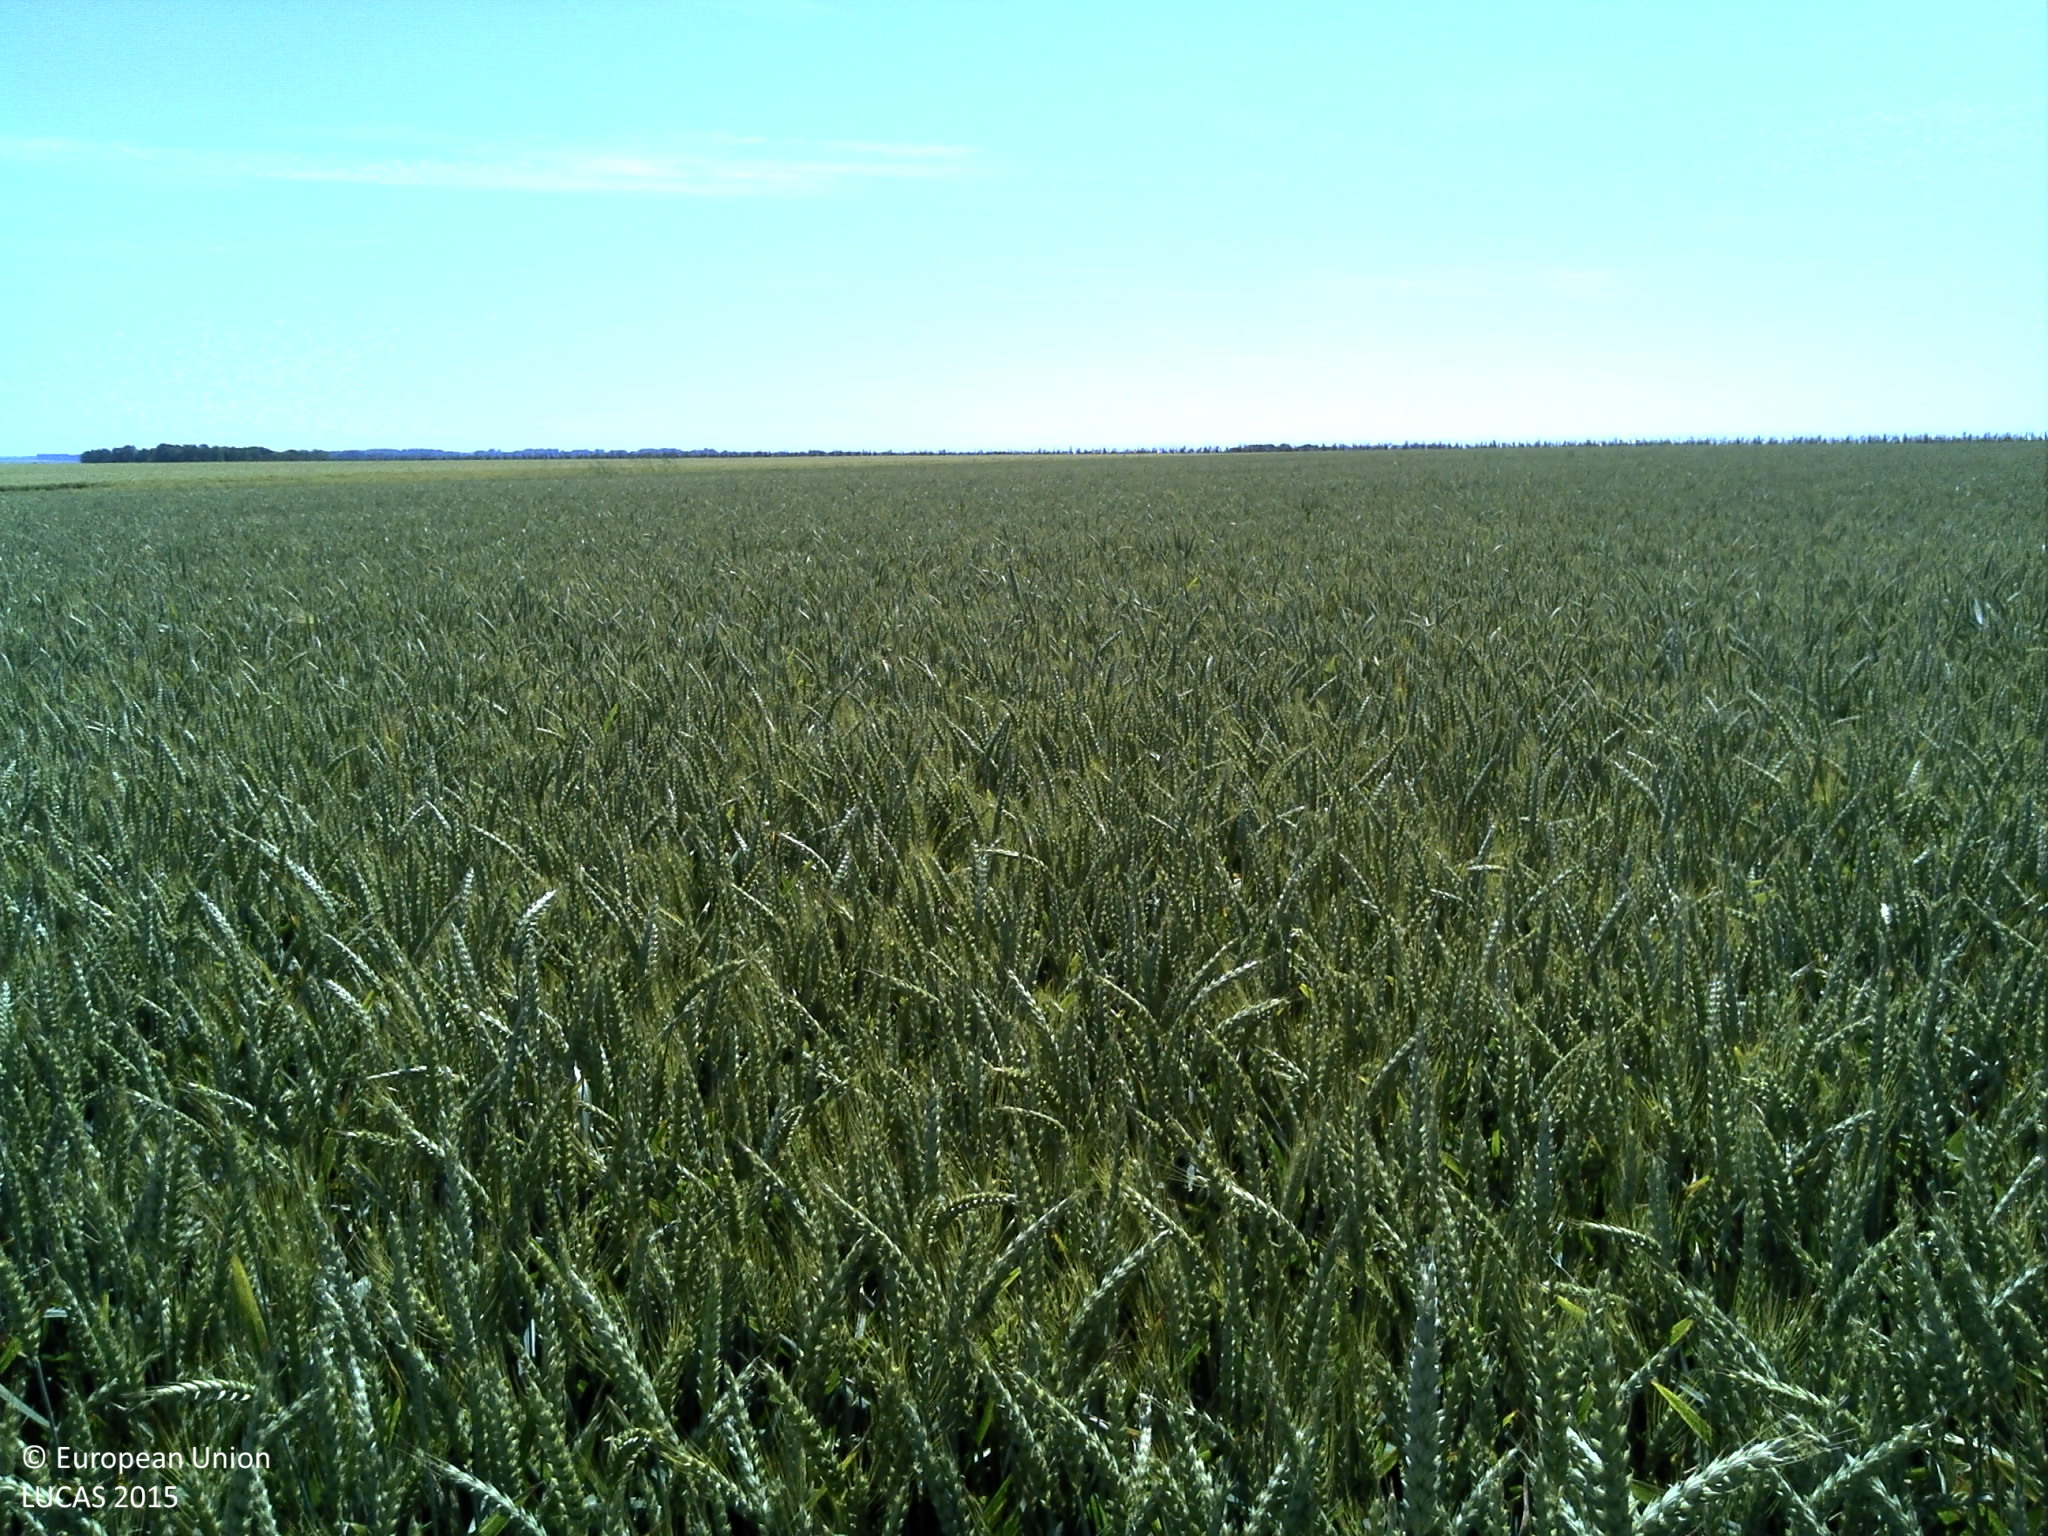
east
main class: Cropland
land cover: Common wheat
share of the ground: > 75 %
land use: Agriculture (excluding fallow land and kitchen gardens)
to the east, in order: Common wheat; Durum wheat
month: June
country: FR
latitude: 49.7707
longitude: 0.9658
